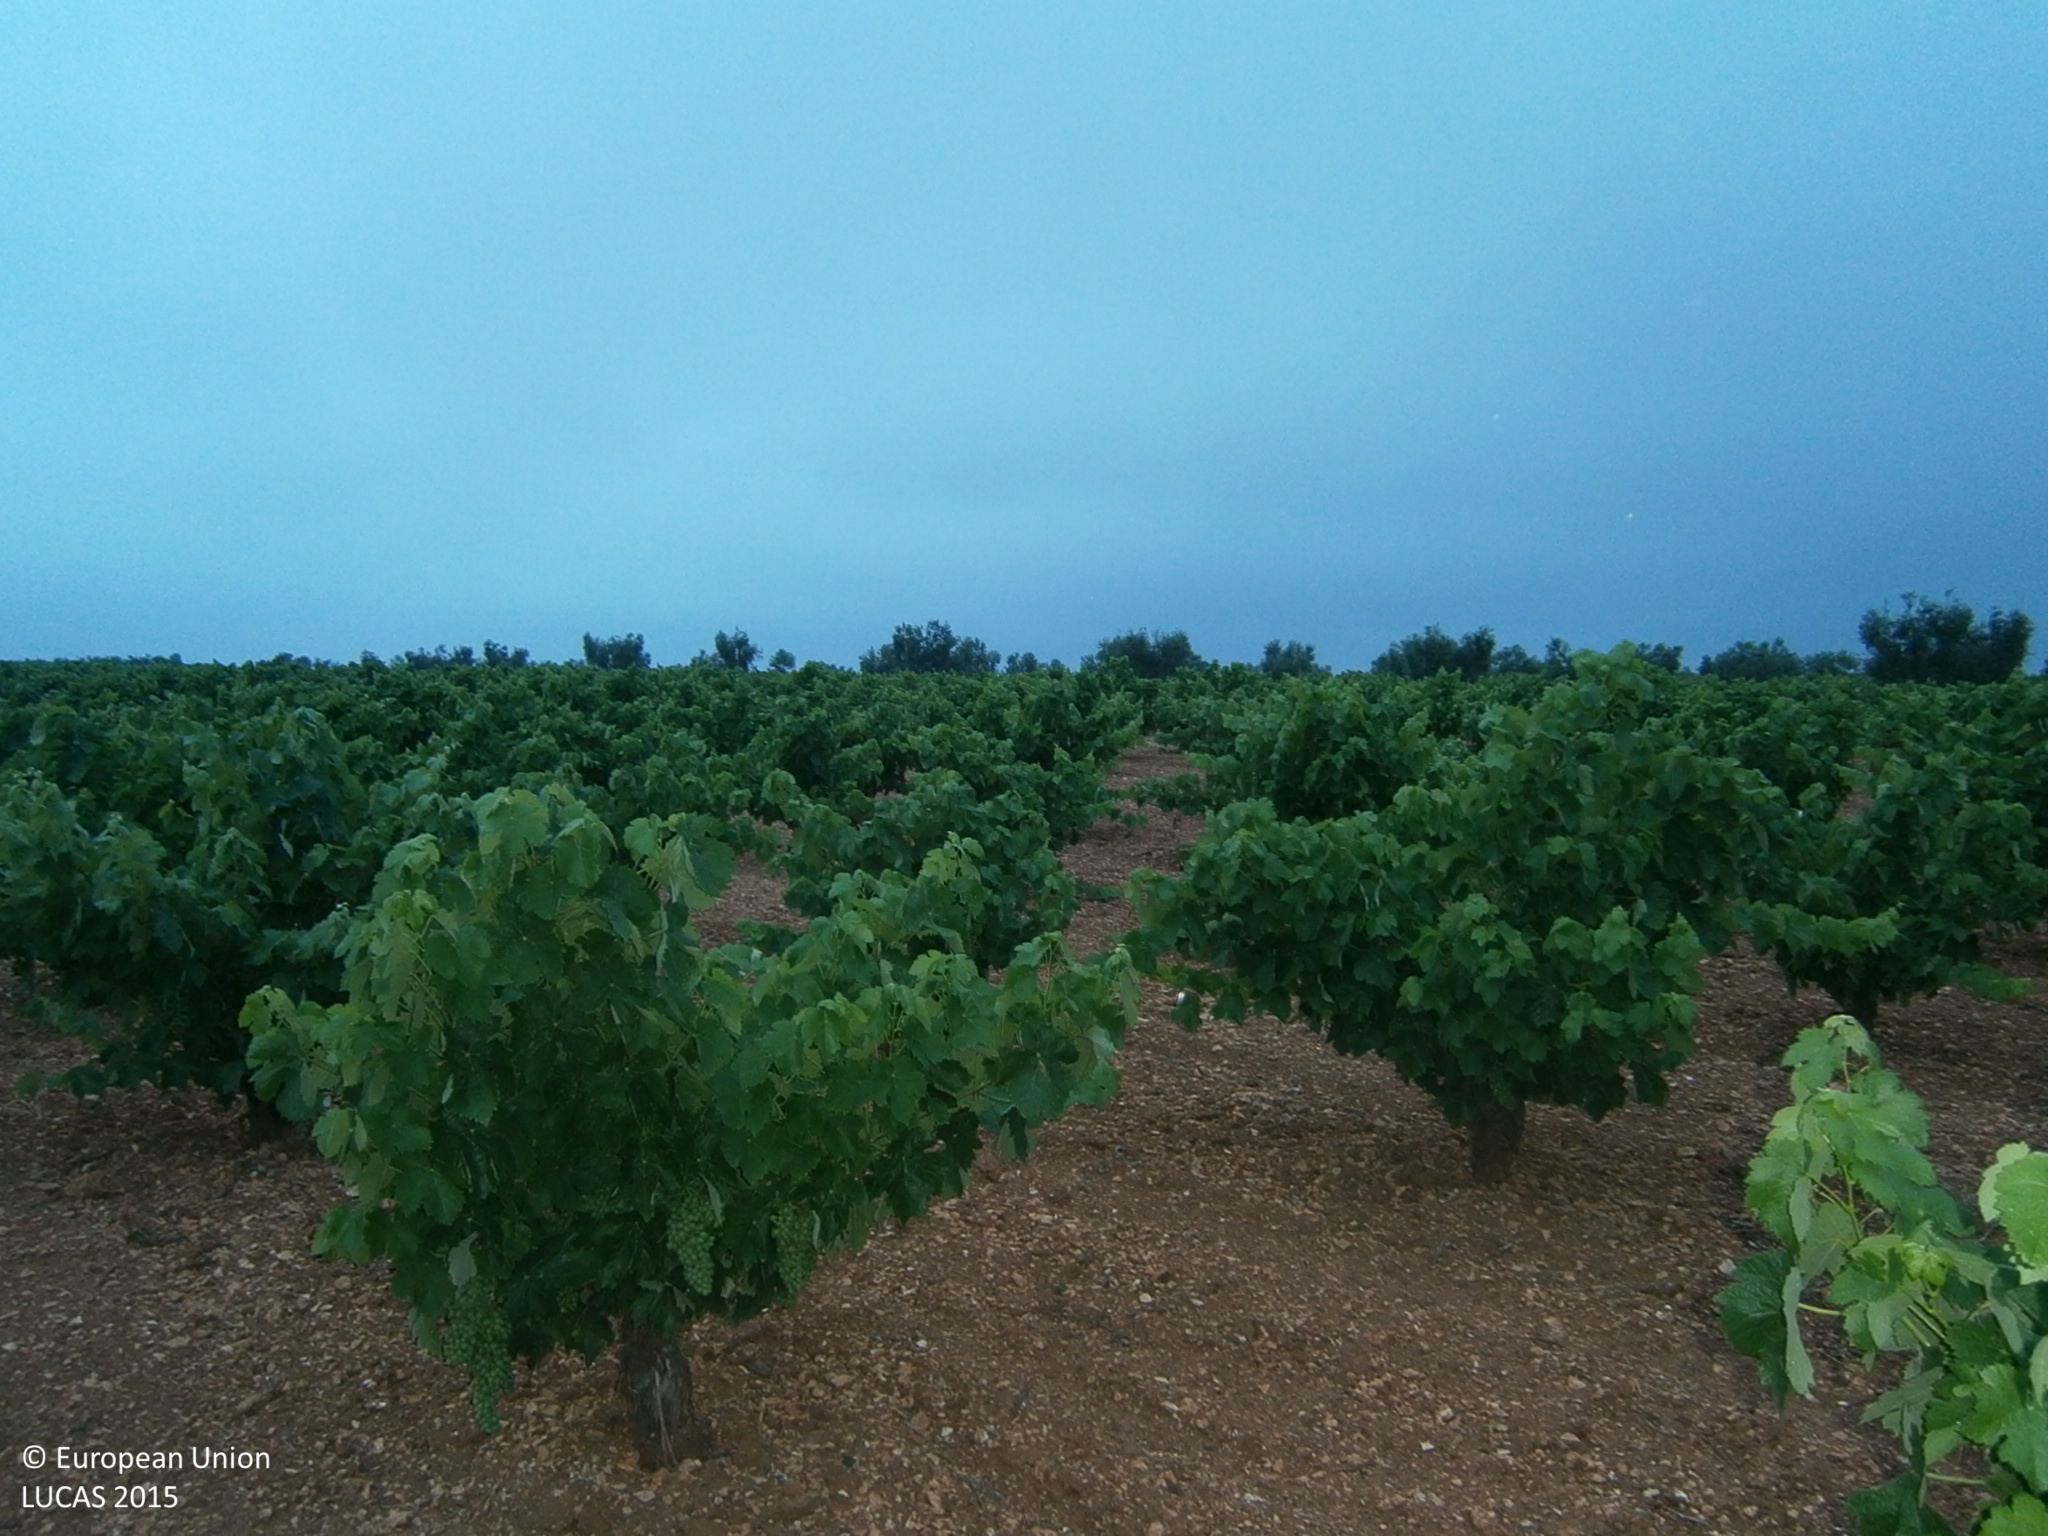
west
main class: Cropland
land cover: Vineyards
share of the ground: 25 - 50 %
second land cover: Other bare soil
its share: > 75 %
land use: Agriculture (excluding fallow land and kitchen gardens)
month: June
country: ES
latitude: 38.5623
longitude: -6.4063
